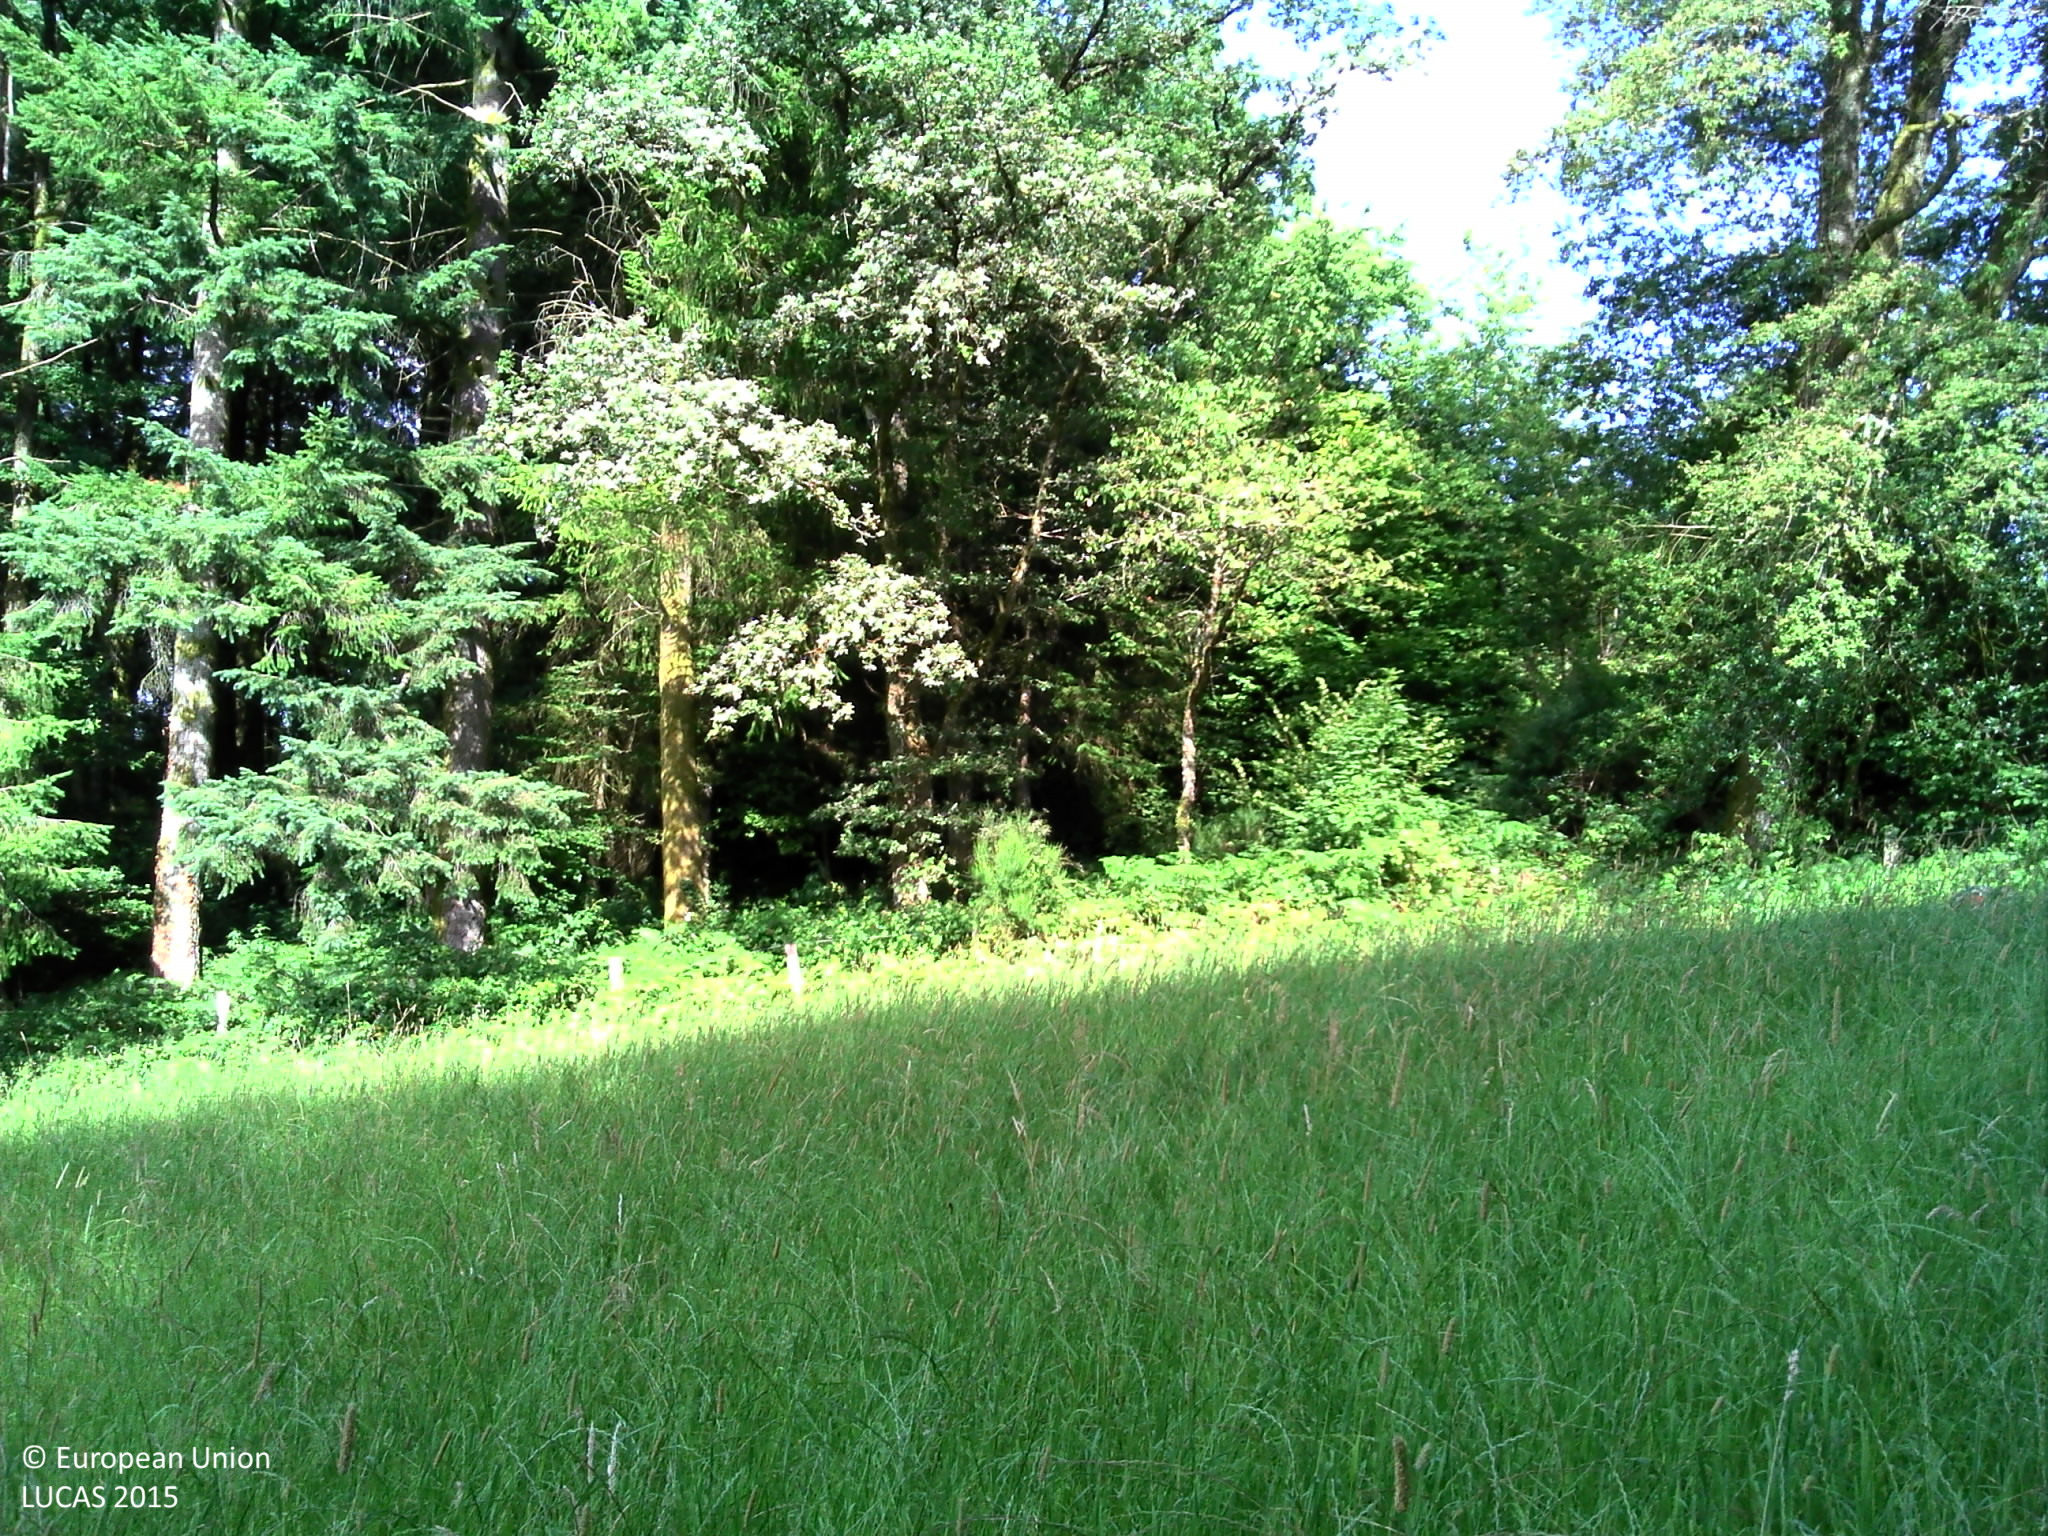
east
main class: Grassland
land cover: Grassland without tree/shrub cover
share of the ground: > 75 %
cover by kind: herbaceous plants 100 %
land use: Agriculture (excluding fallow land and kitchen gardens)
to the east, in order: Grassland without tree/shrub cover; Fences; Broadleaved woodland; Tracks; Broadleaved woodland; Spontaneously vegetated surfaces; Lines of trees; Fences; Grassland without tree/shrub cover
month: July
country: FR
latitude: 45.6713
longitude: 1.7661
